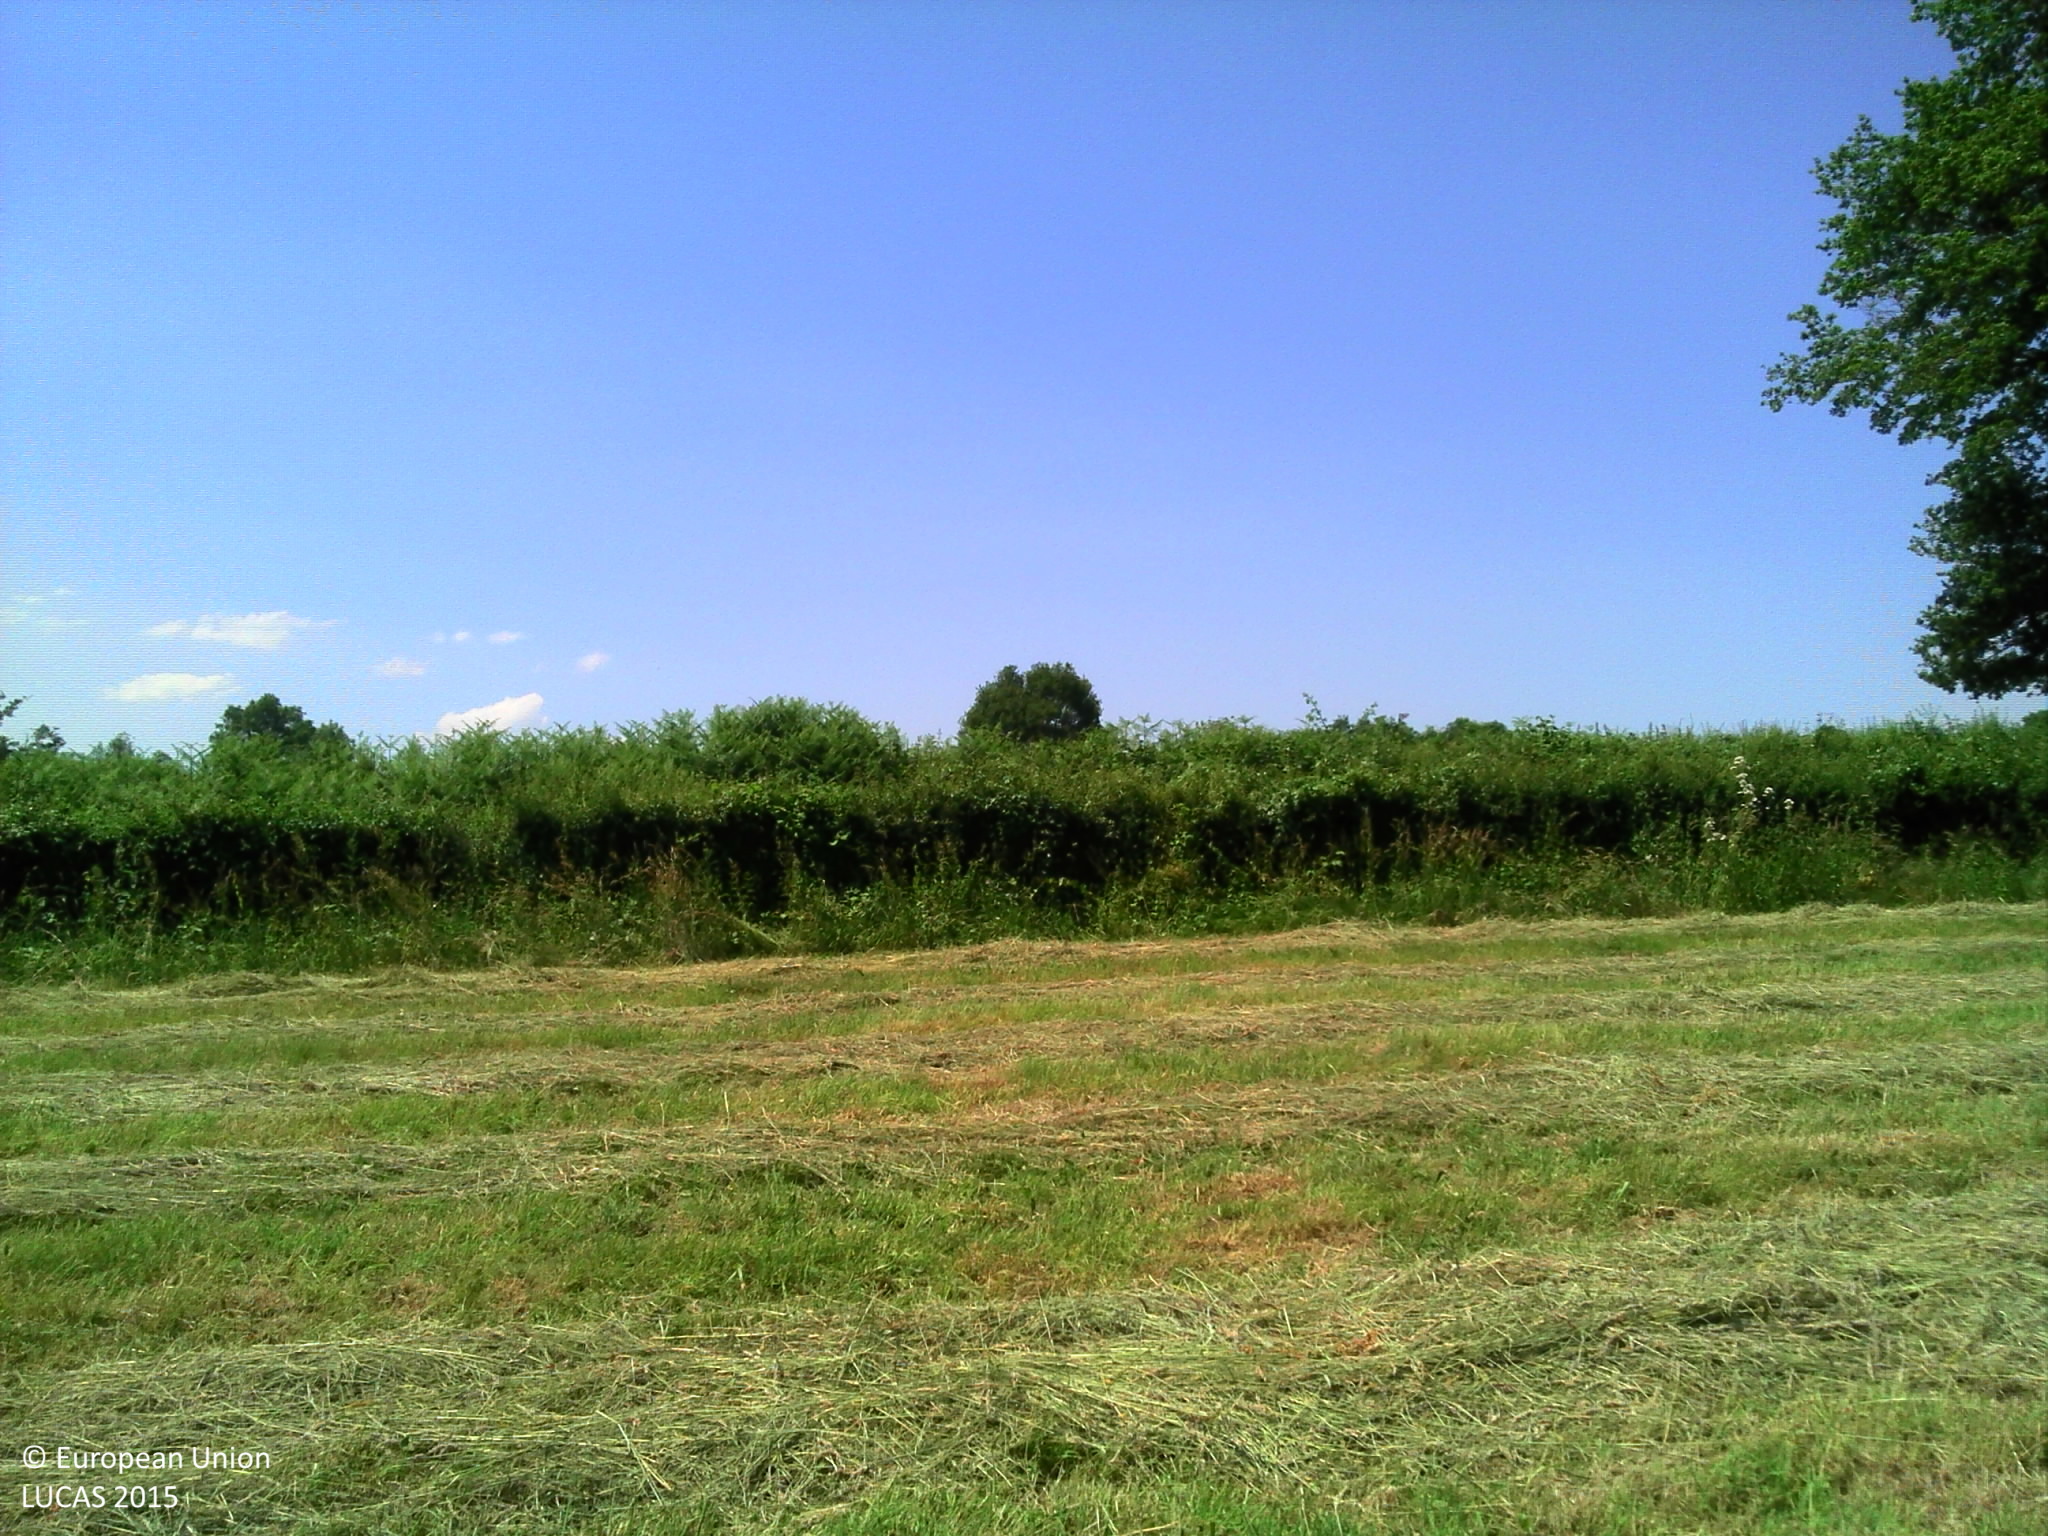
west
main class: Grassland
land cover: Grassland without tree/shrub cover
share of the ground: > 75 %
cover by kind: herbaceous plants 100 %
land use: Agriculture (excluding fallow land and kitchen gardens)
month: June
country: FR
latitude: 46.3551
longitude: 2.7058
